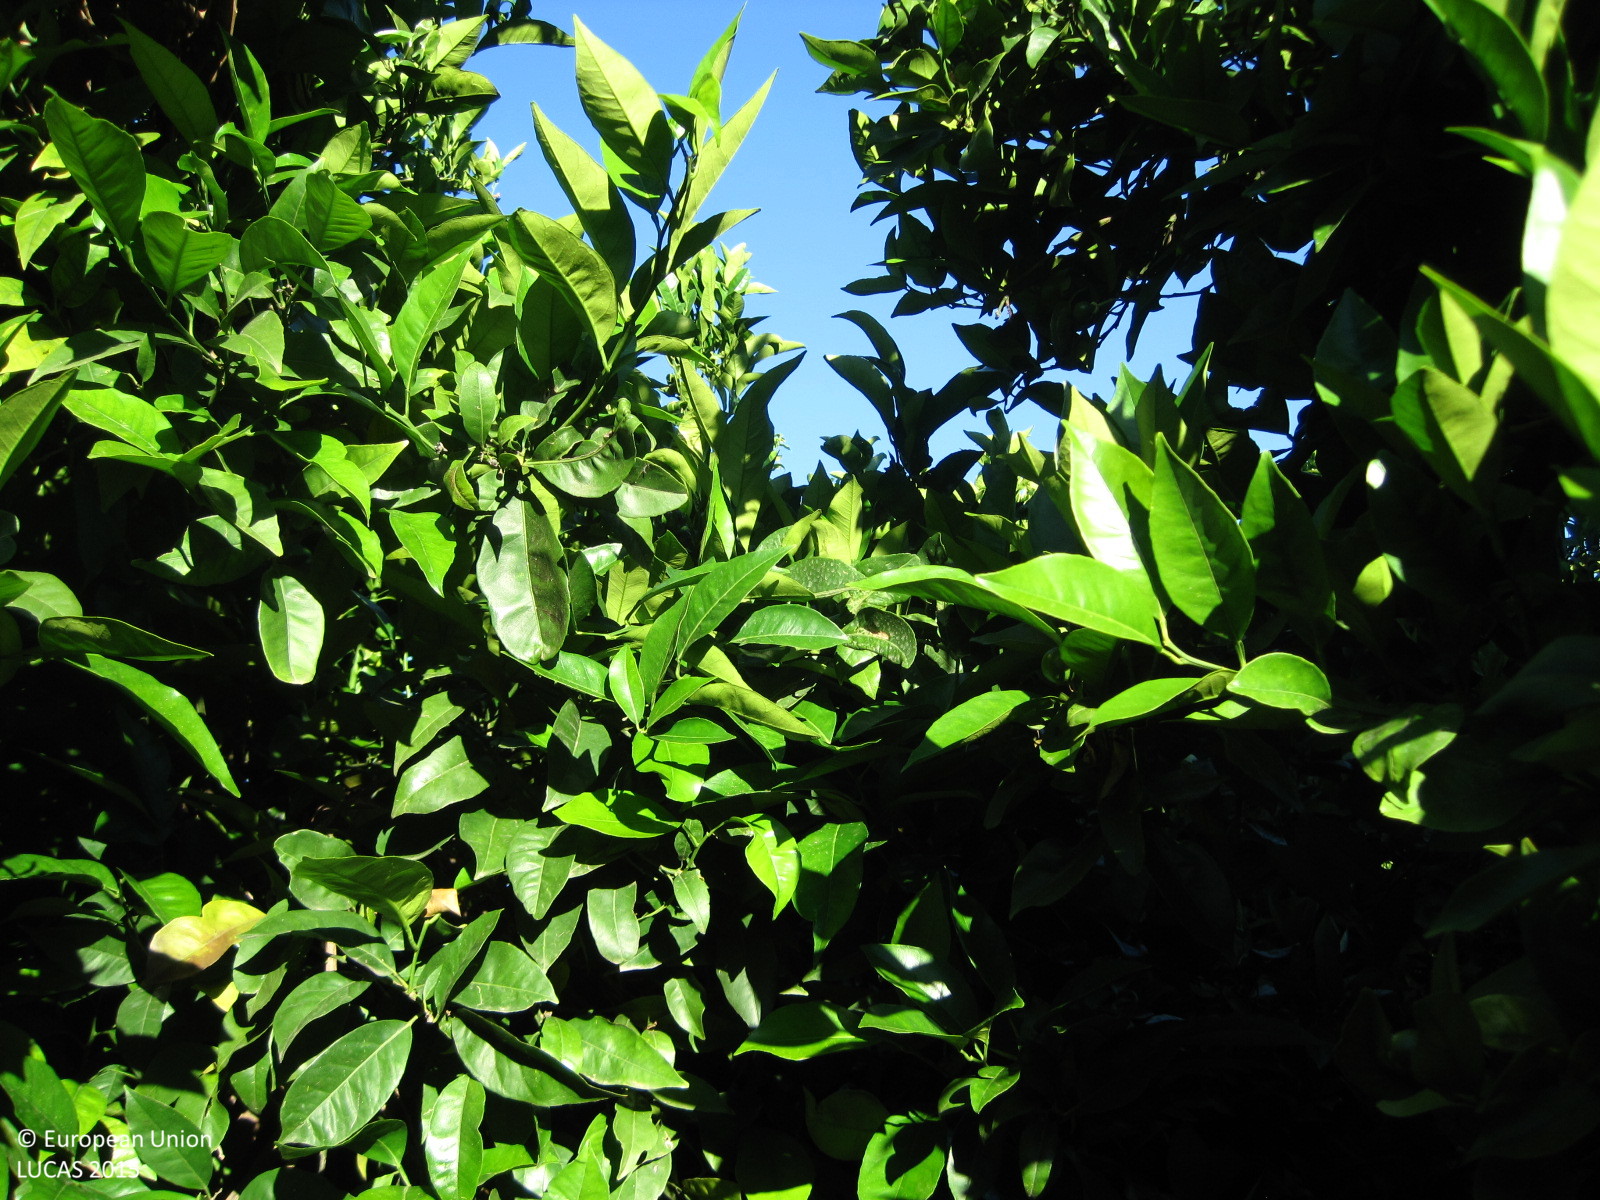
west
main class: Cropland
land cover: Oranges
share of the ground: > 75 %
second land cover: Other bare soil
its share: > 75 %
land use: Agriculture (excluding fallow land and kitchen gardens)
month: May
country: ES
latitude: 39.7171
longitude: -0.6986
